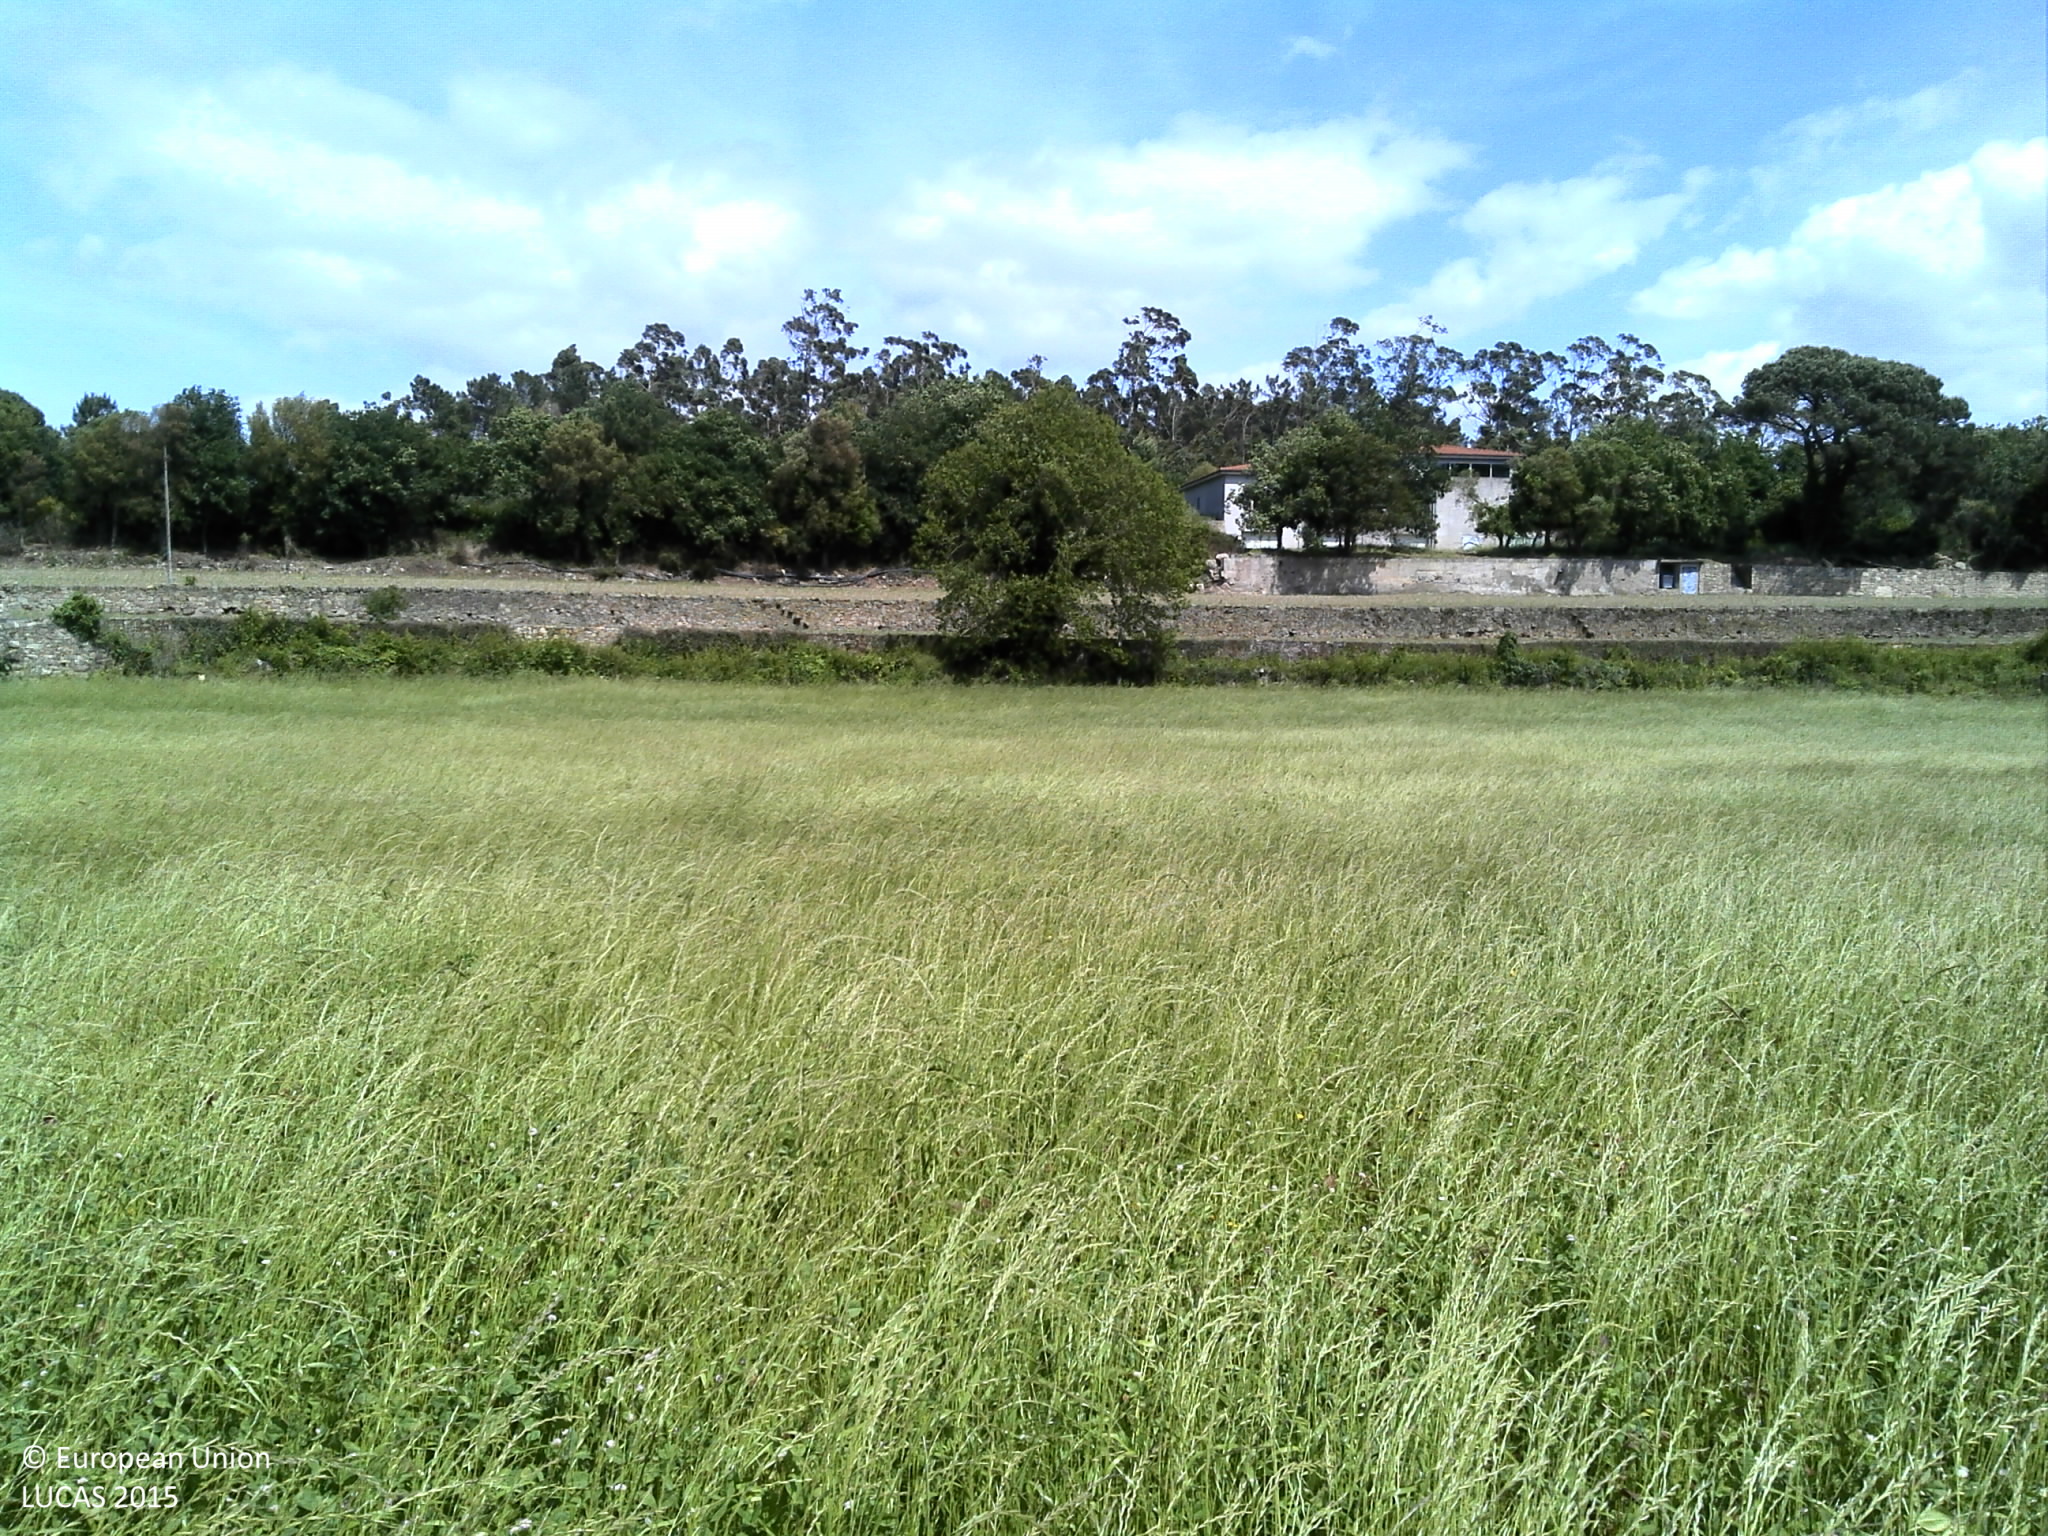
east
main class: Grassland
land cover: Spontaneously vegetated surfaces
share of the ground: > 75 %
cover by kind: herbaceous plants 80 %, unconsolidated bare surface 20 %
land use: Fallow land
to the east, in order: Spontaneously vegetated surfaces; Single bushes/trees; Shruby margins; Dry stone walls; Maize; Dry stone walls; Maize; Abandoned hedges; Tracks; Shrubland without tree cover; Tracks; Shrubland with sparse tree cover; Broadleaved woodland; Dry stone walls; Paved roads, cycling and walking lanes; Dry stone walls; Broadleaved woodland
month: May
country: PT
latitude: 41.3959
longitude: -8.6856
